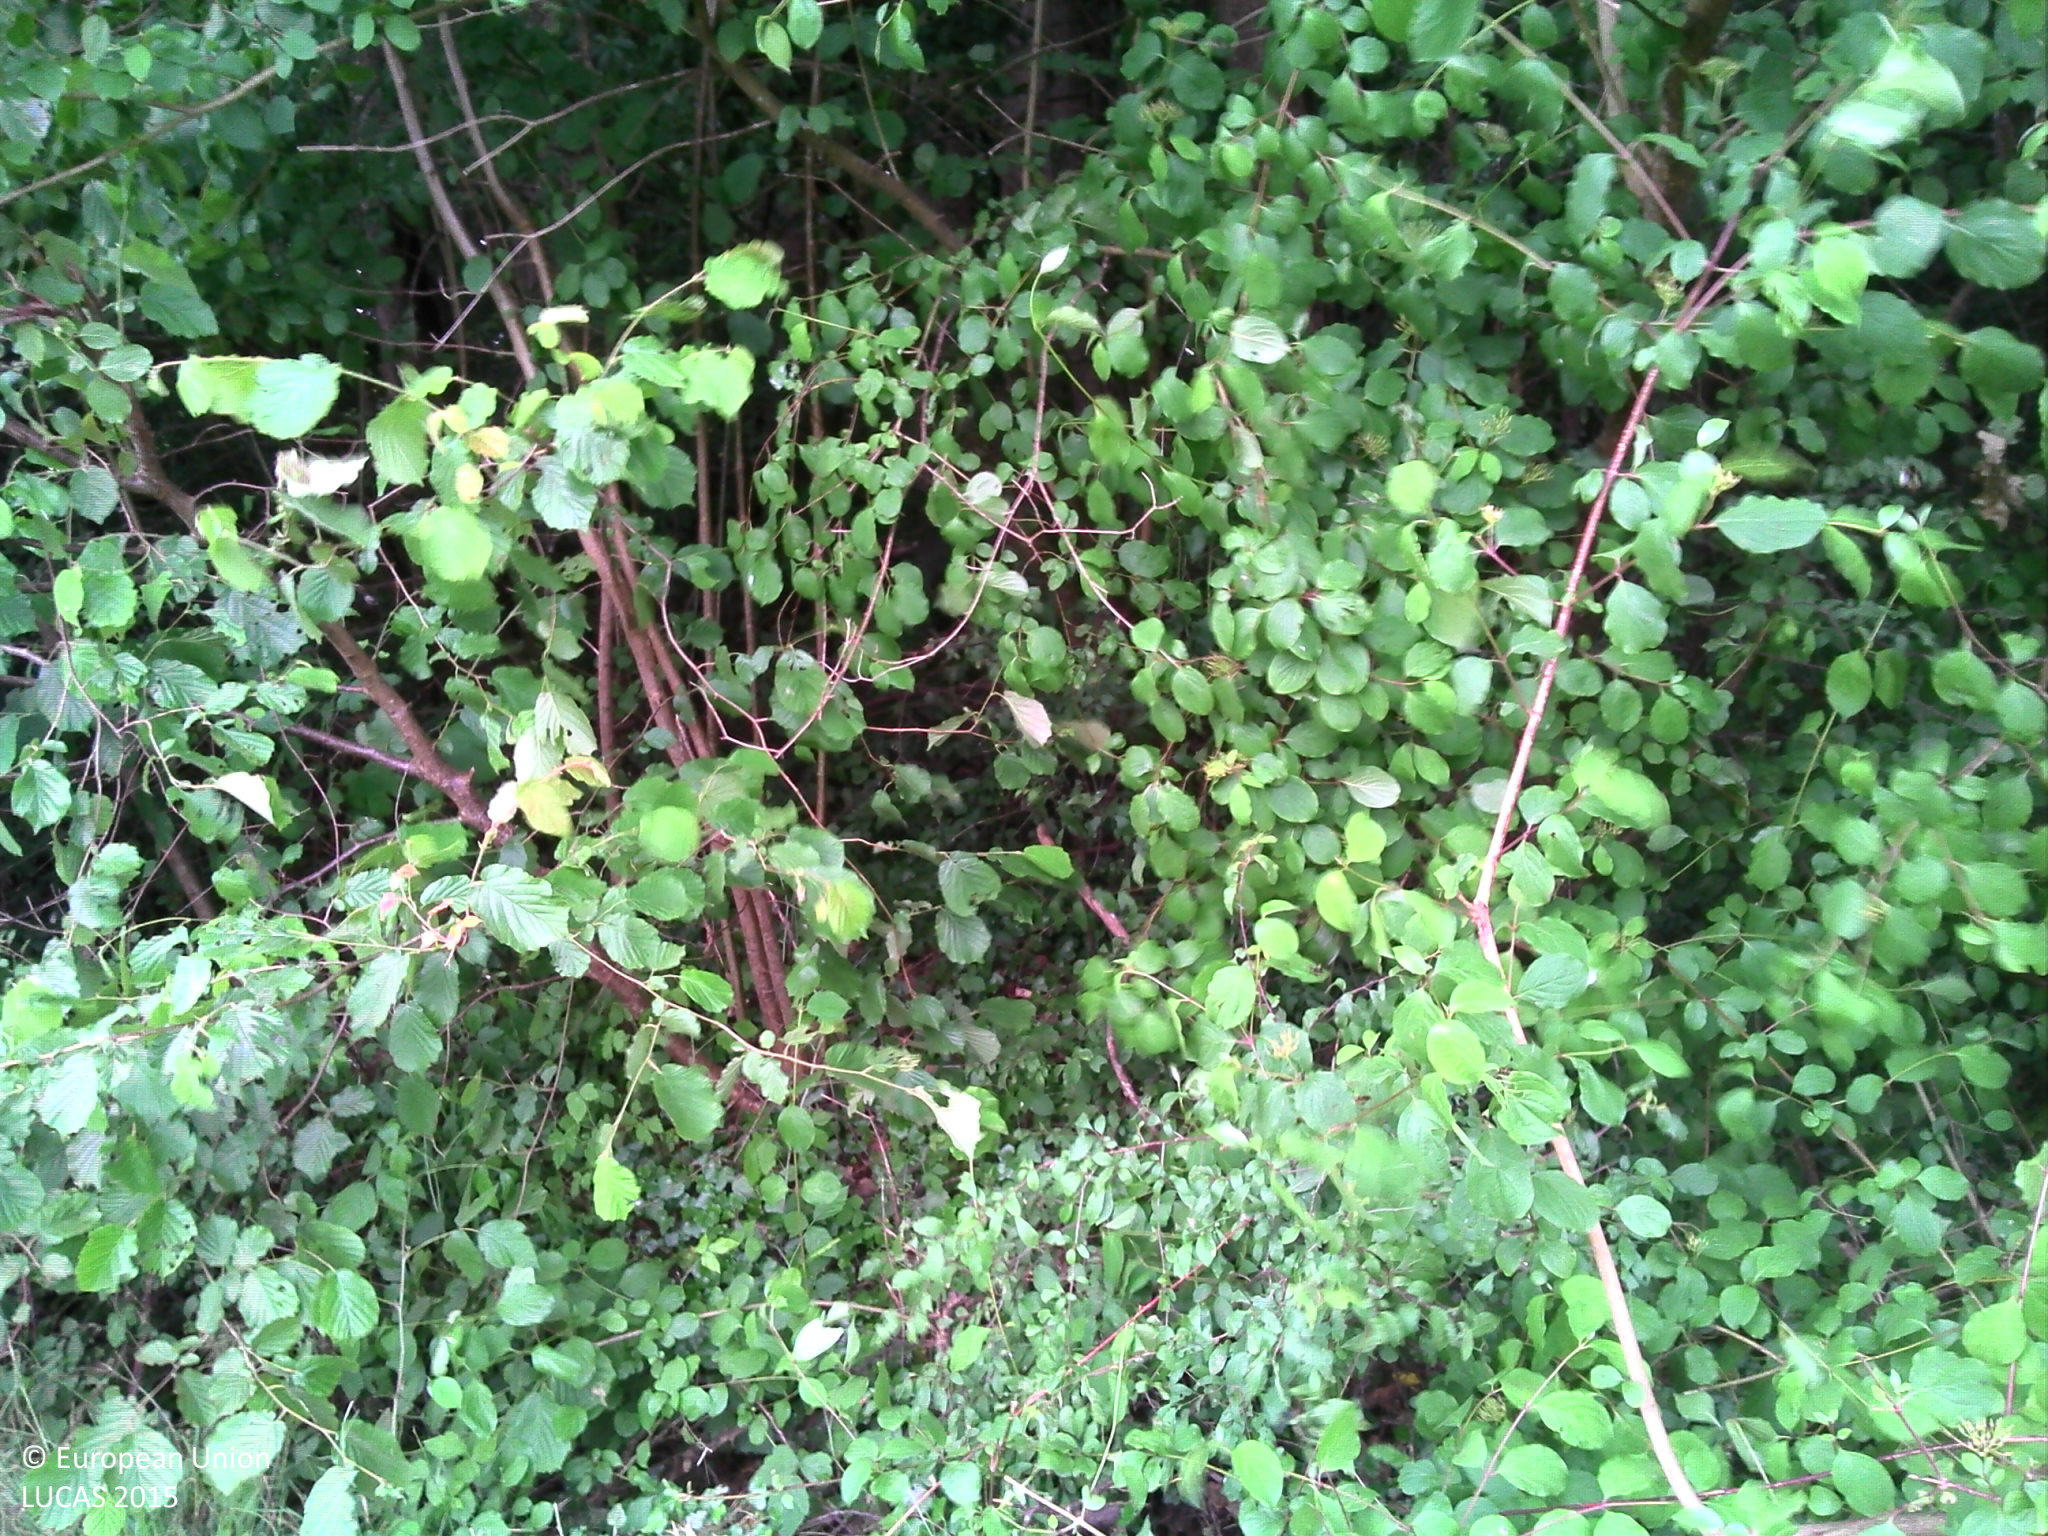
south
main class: Grassland
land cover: Grassland without tree/shrub cover
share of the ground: > 75 %
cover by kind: herbaceous plants 100 %
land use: Agriculture (excluding fallow land and kitchen gardens)
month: June
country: FR
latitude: 47.5155
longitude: 6.3763
